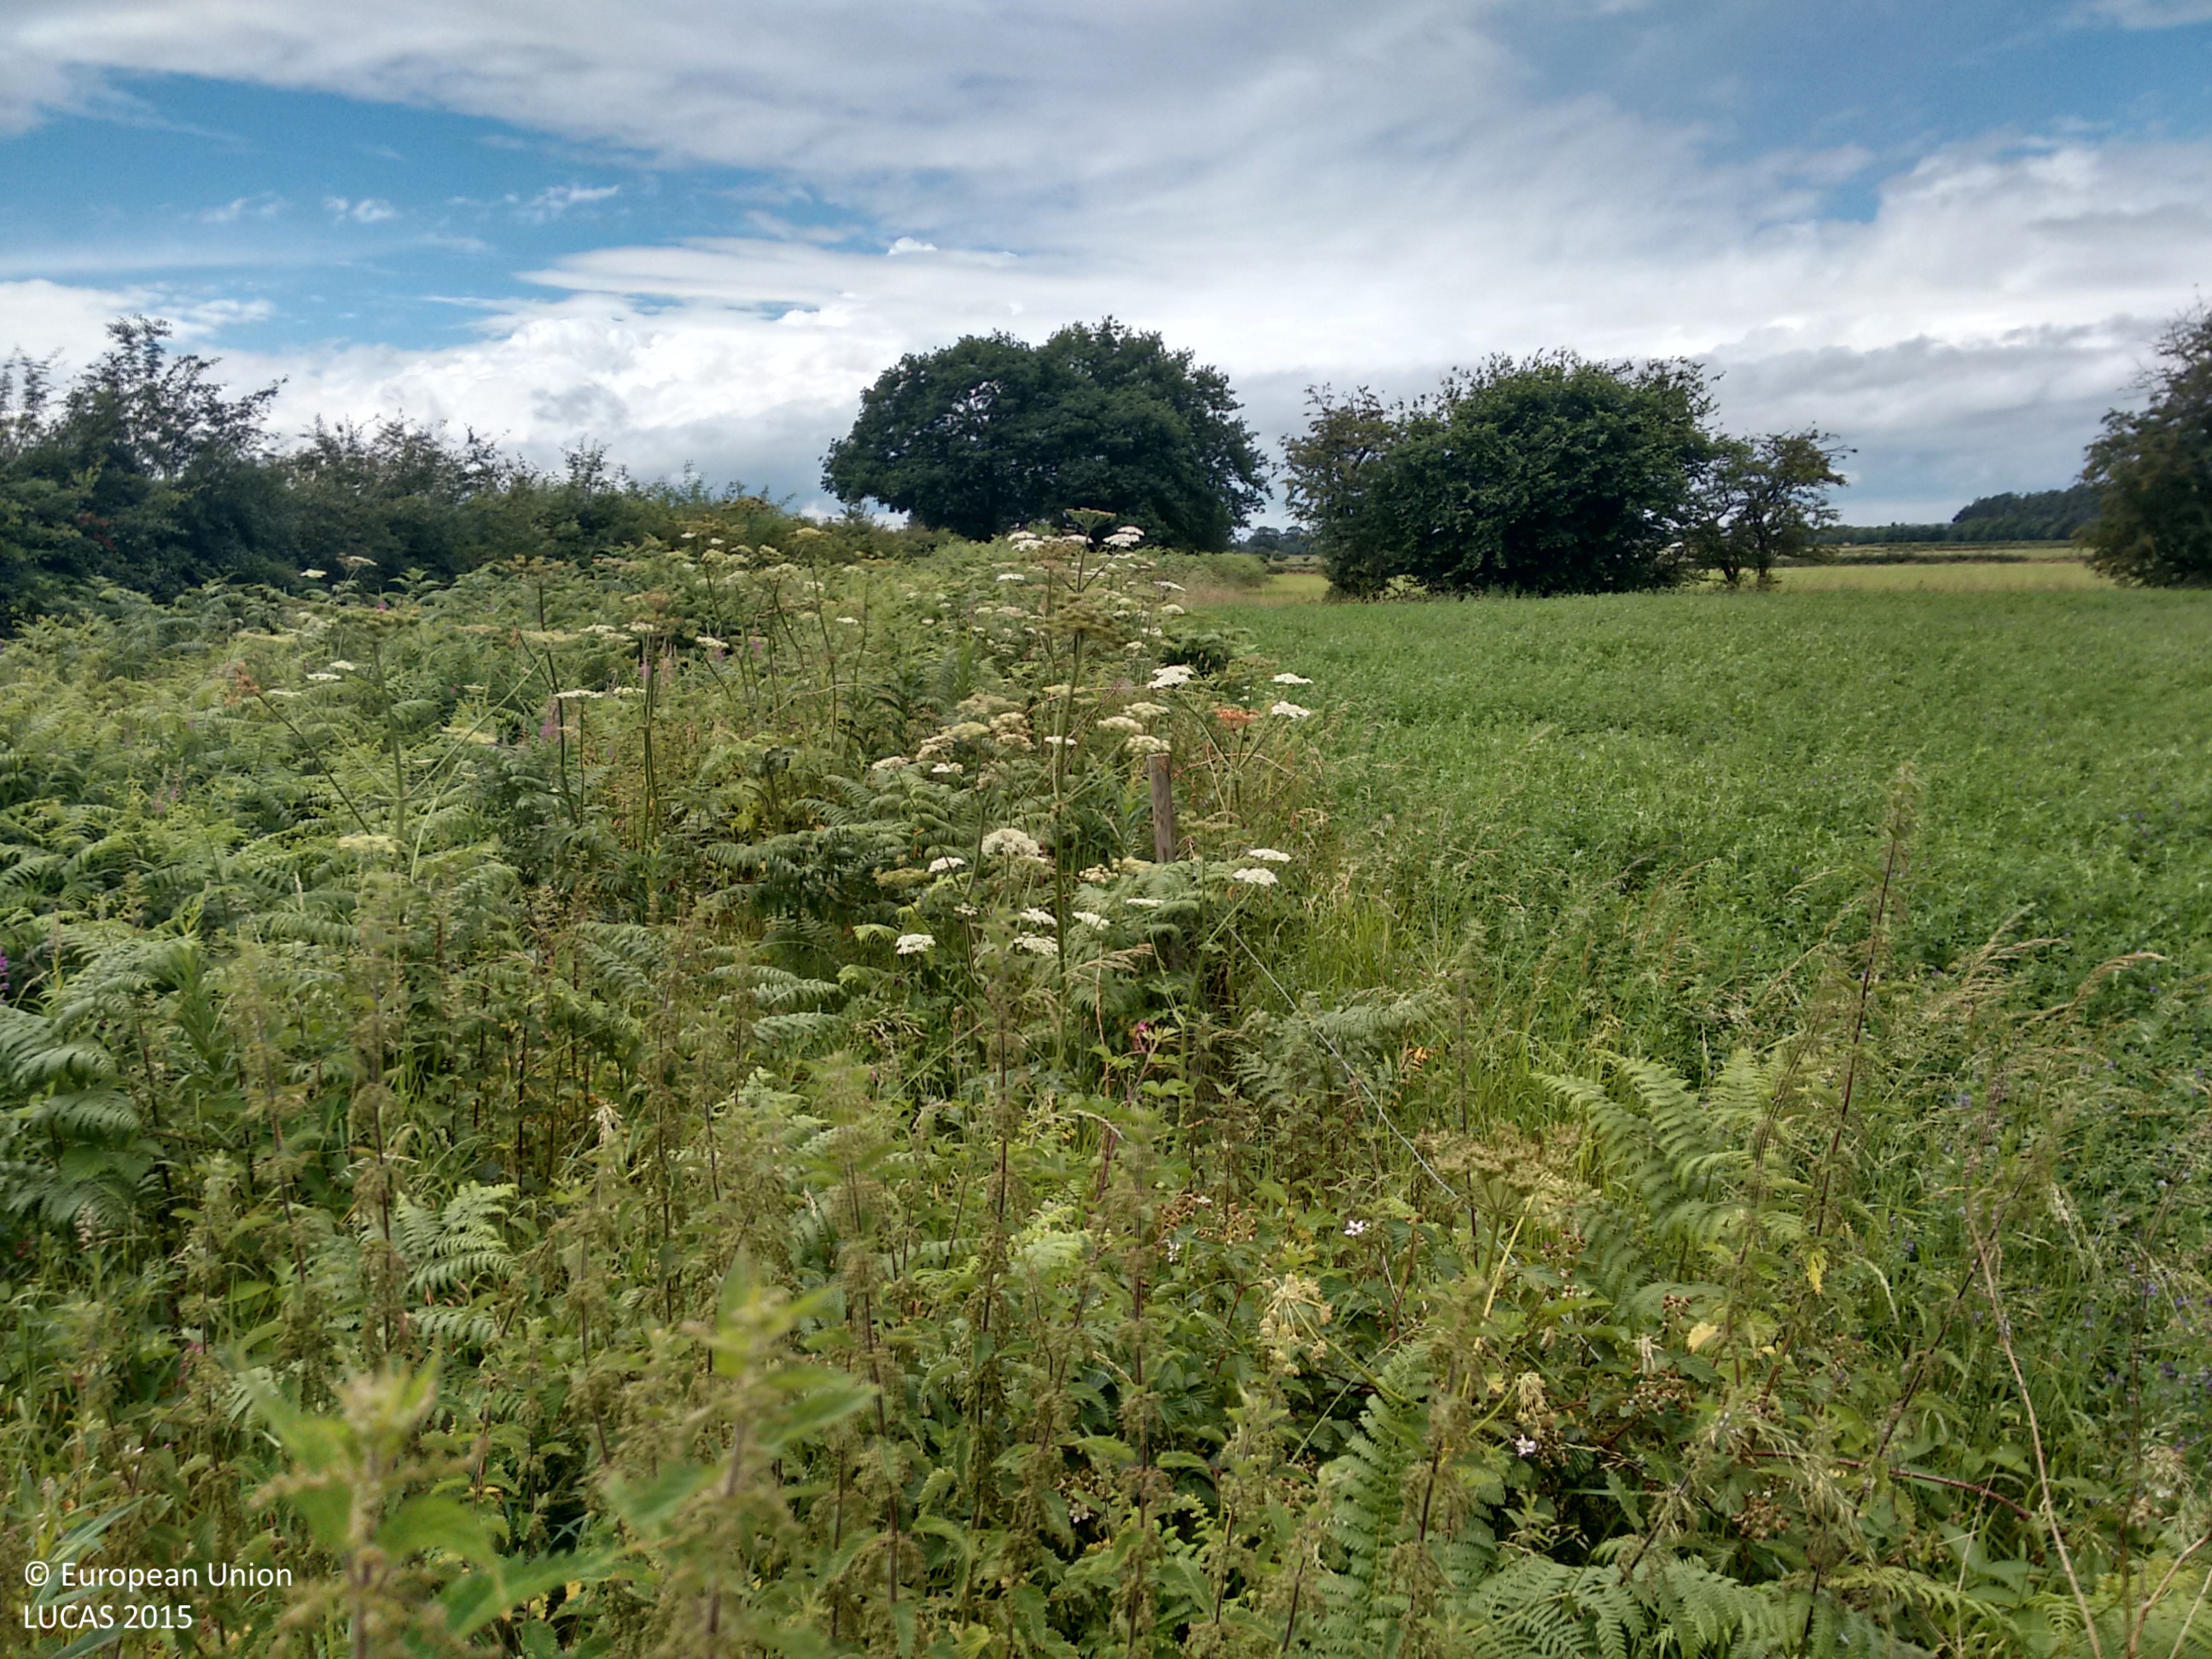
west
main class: Cropland
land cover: Other fibre and oleaginous crops
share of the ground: > 75 %
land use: Agriculture (excluding fallow land and kitchen gardens)
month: July
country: GB
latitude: 53.4270
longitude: -0.9843
